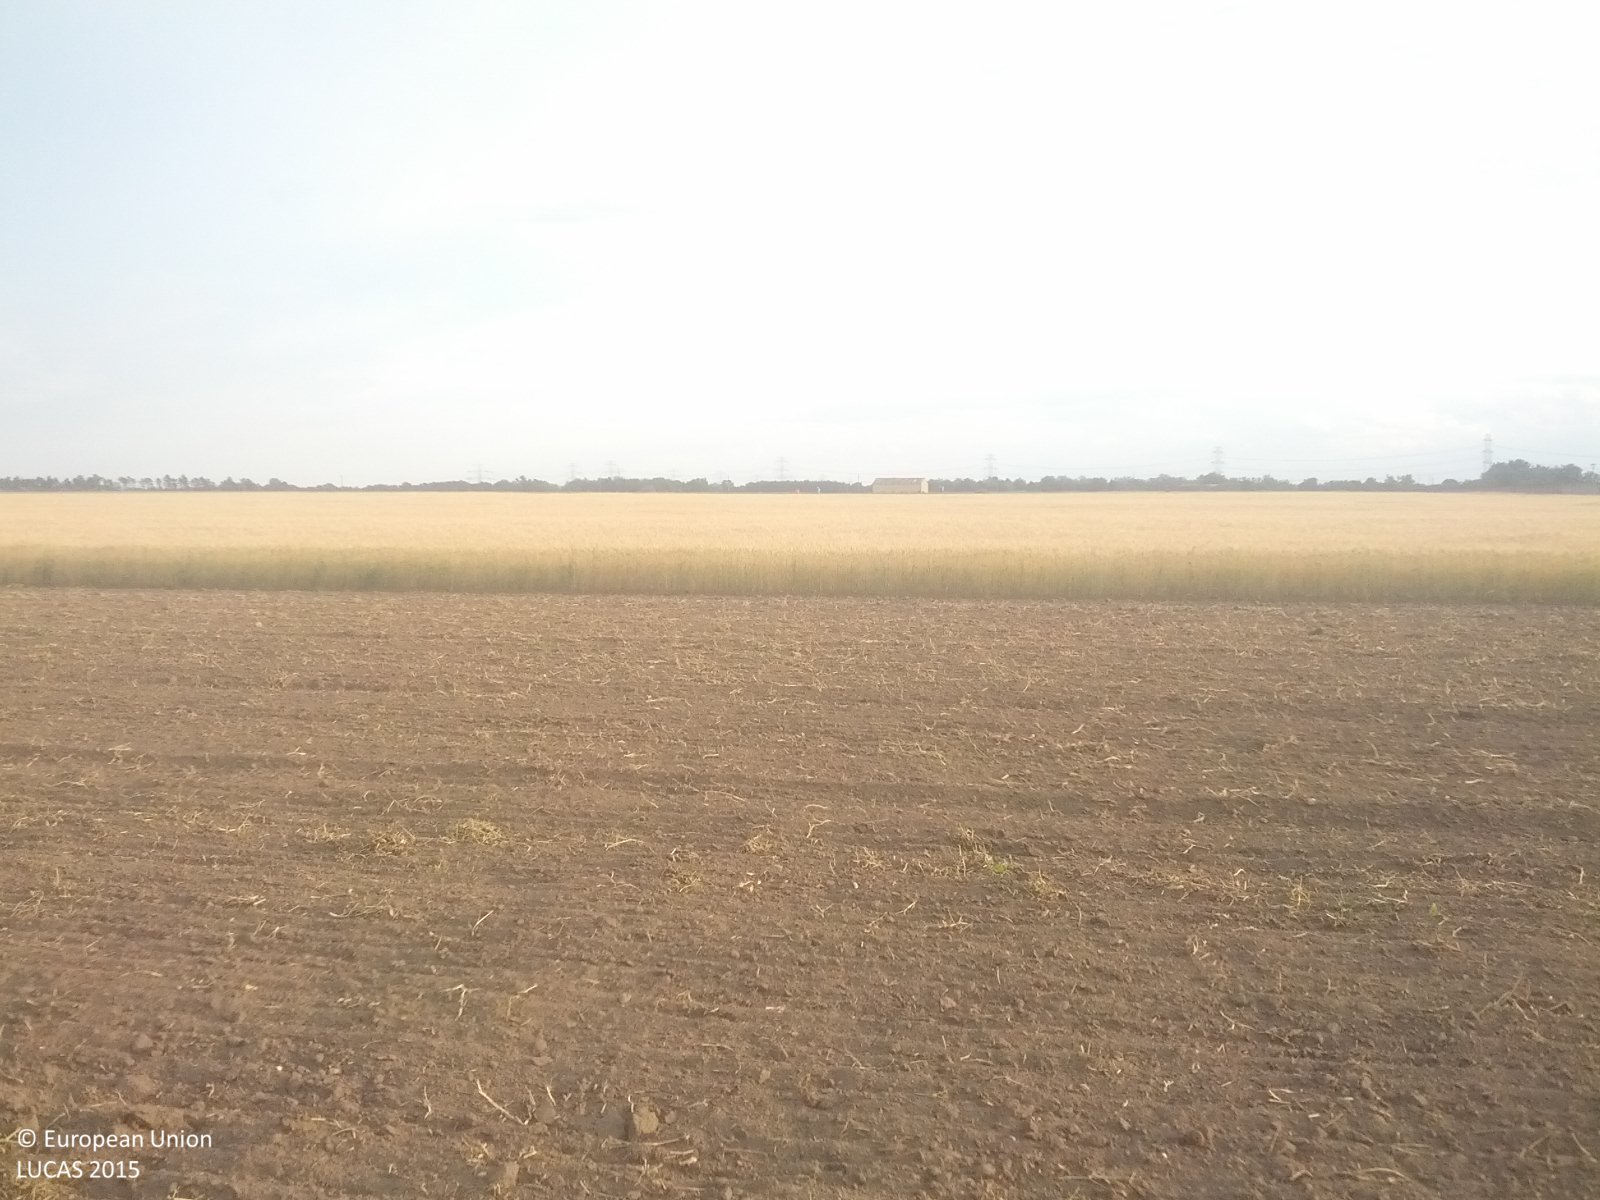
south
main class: Cropland
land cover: Dry pulses
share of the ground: < 10 %
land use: Agriculture (excluding fallow land and kitchen gardens)
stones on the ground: 10 - 25 %
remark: Harvested field
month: June
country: AT
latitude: 48.2983
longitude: 16.5708
